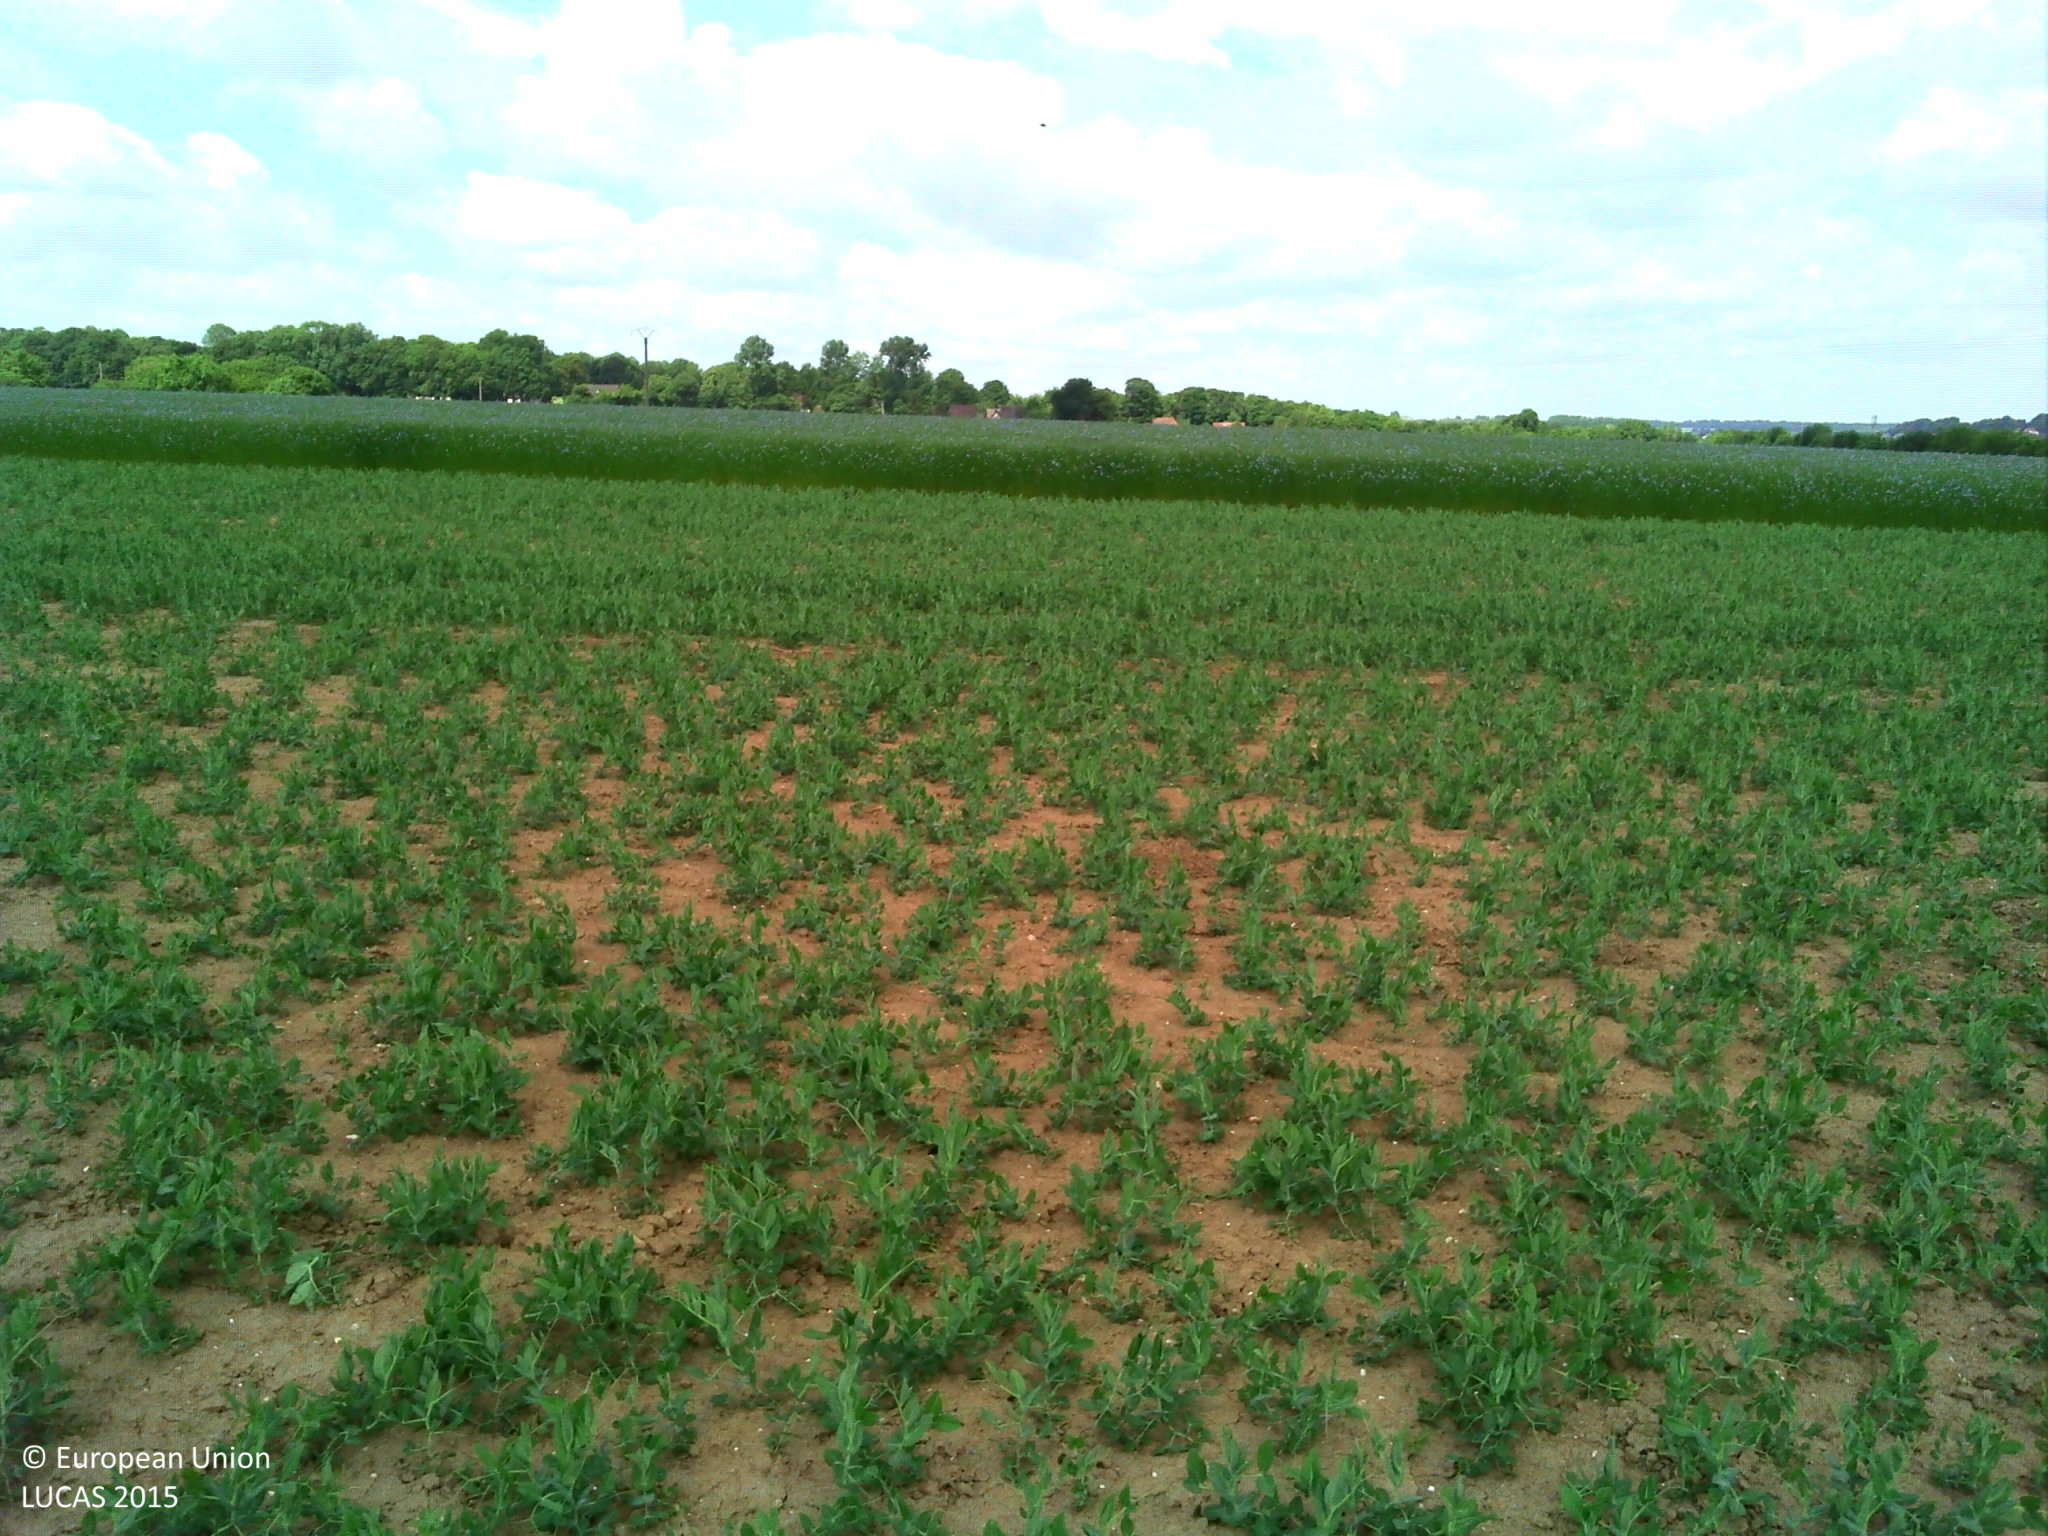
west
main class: Cropland
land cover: Other fresh vegetables
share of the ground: 50 - 75 %
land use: Agriculture (excluding fallow land and kitchen gardens)
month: June
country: FR
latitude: 50.3627
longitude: 2.3816
